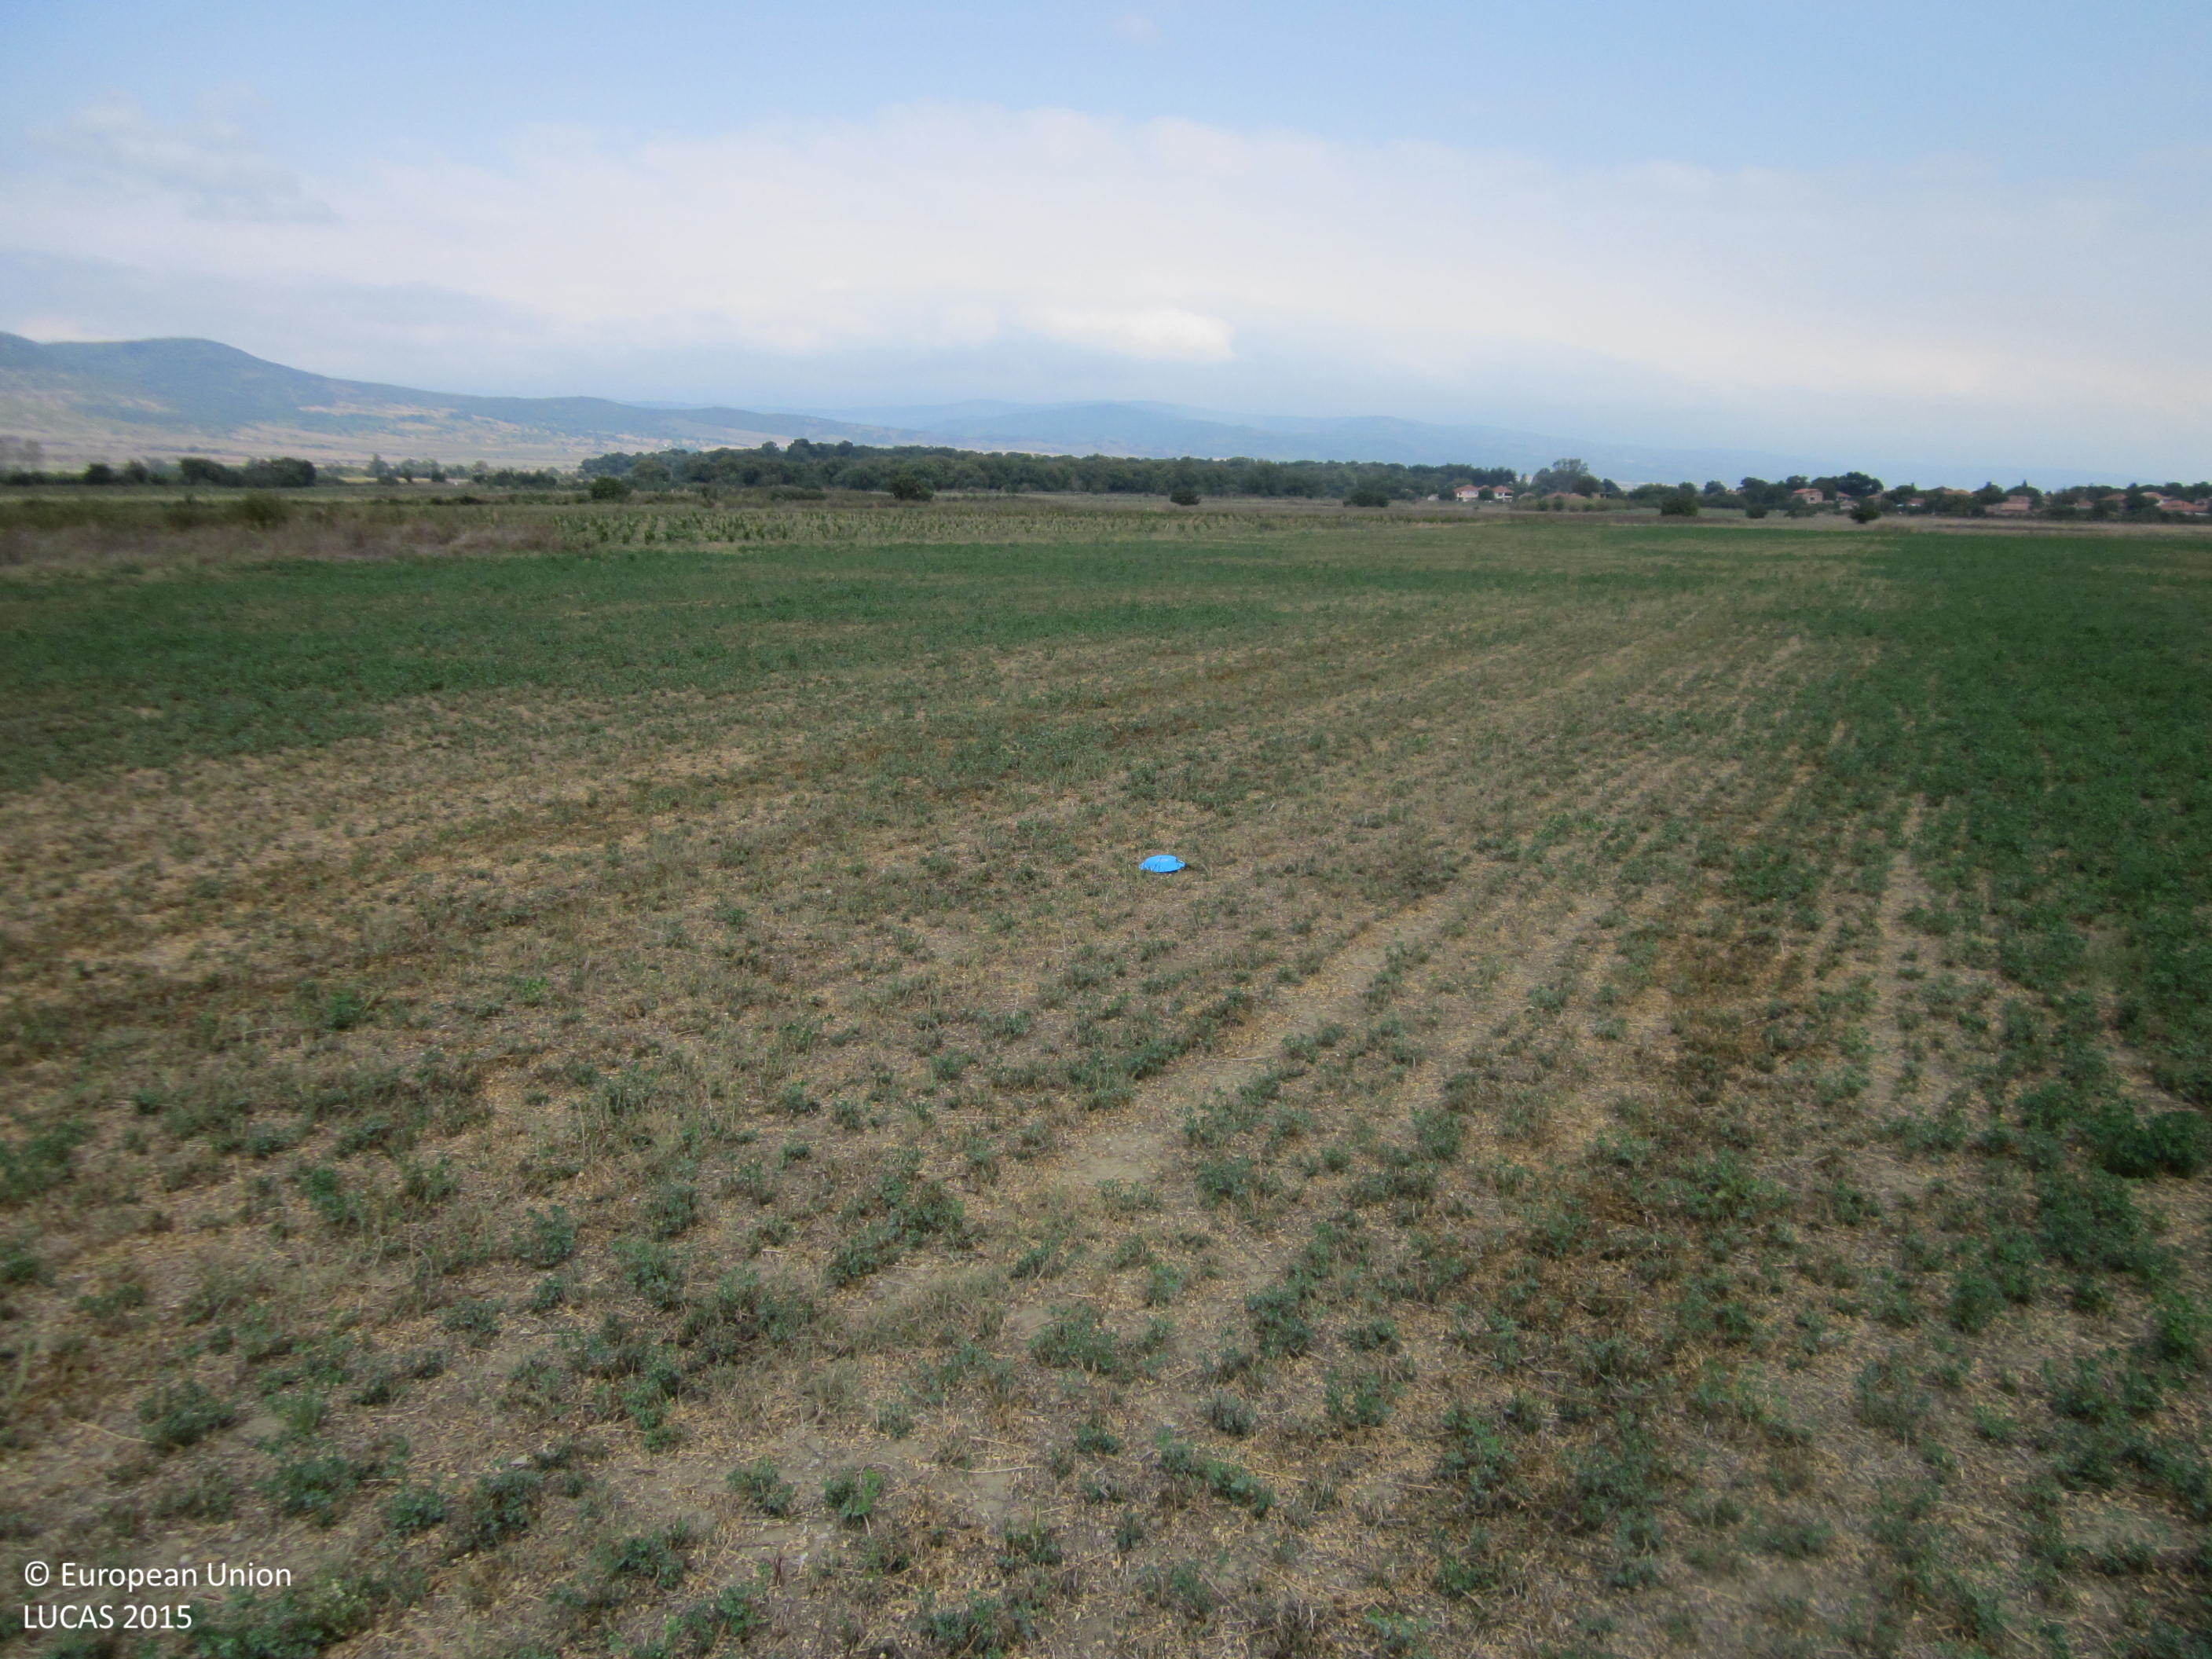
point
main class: Cropland
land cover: Lucerne
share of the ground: 50 - 75 %
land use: Agriculture (excluding fallow land and kitchen gardens)
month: September
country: BG
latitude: 42.7731
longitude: 27.5136
